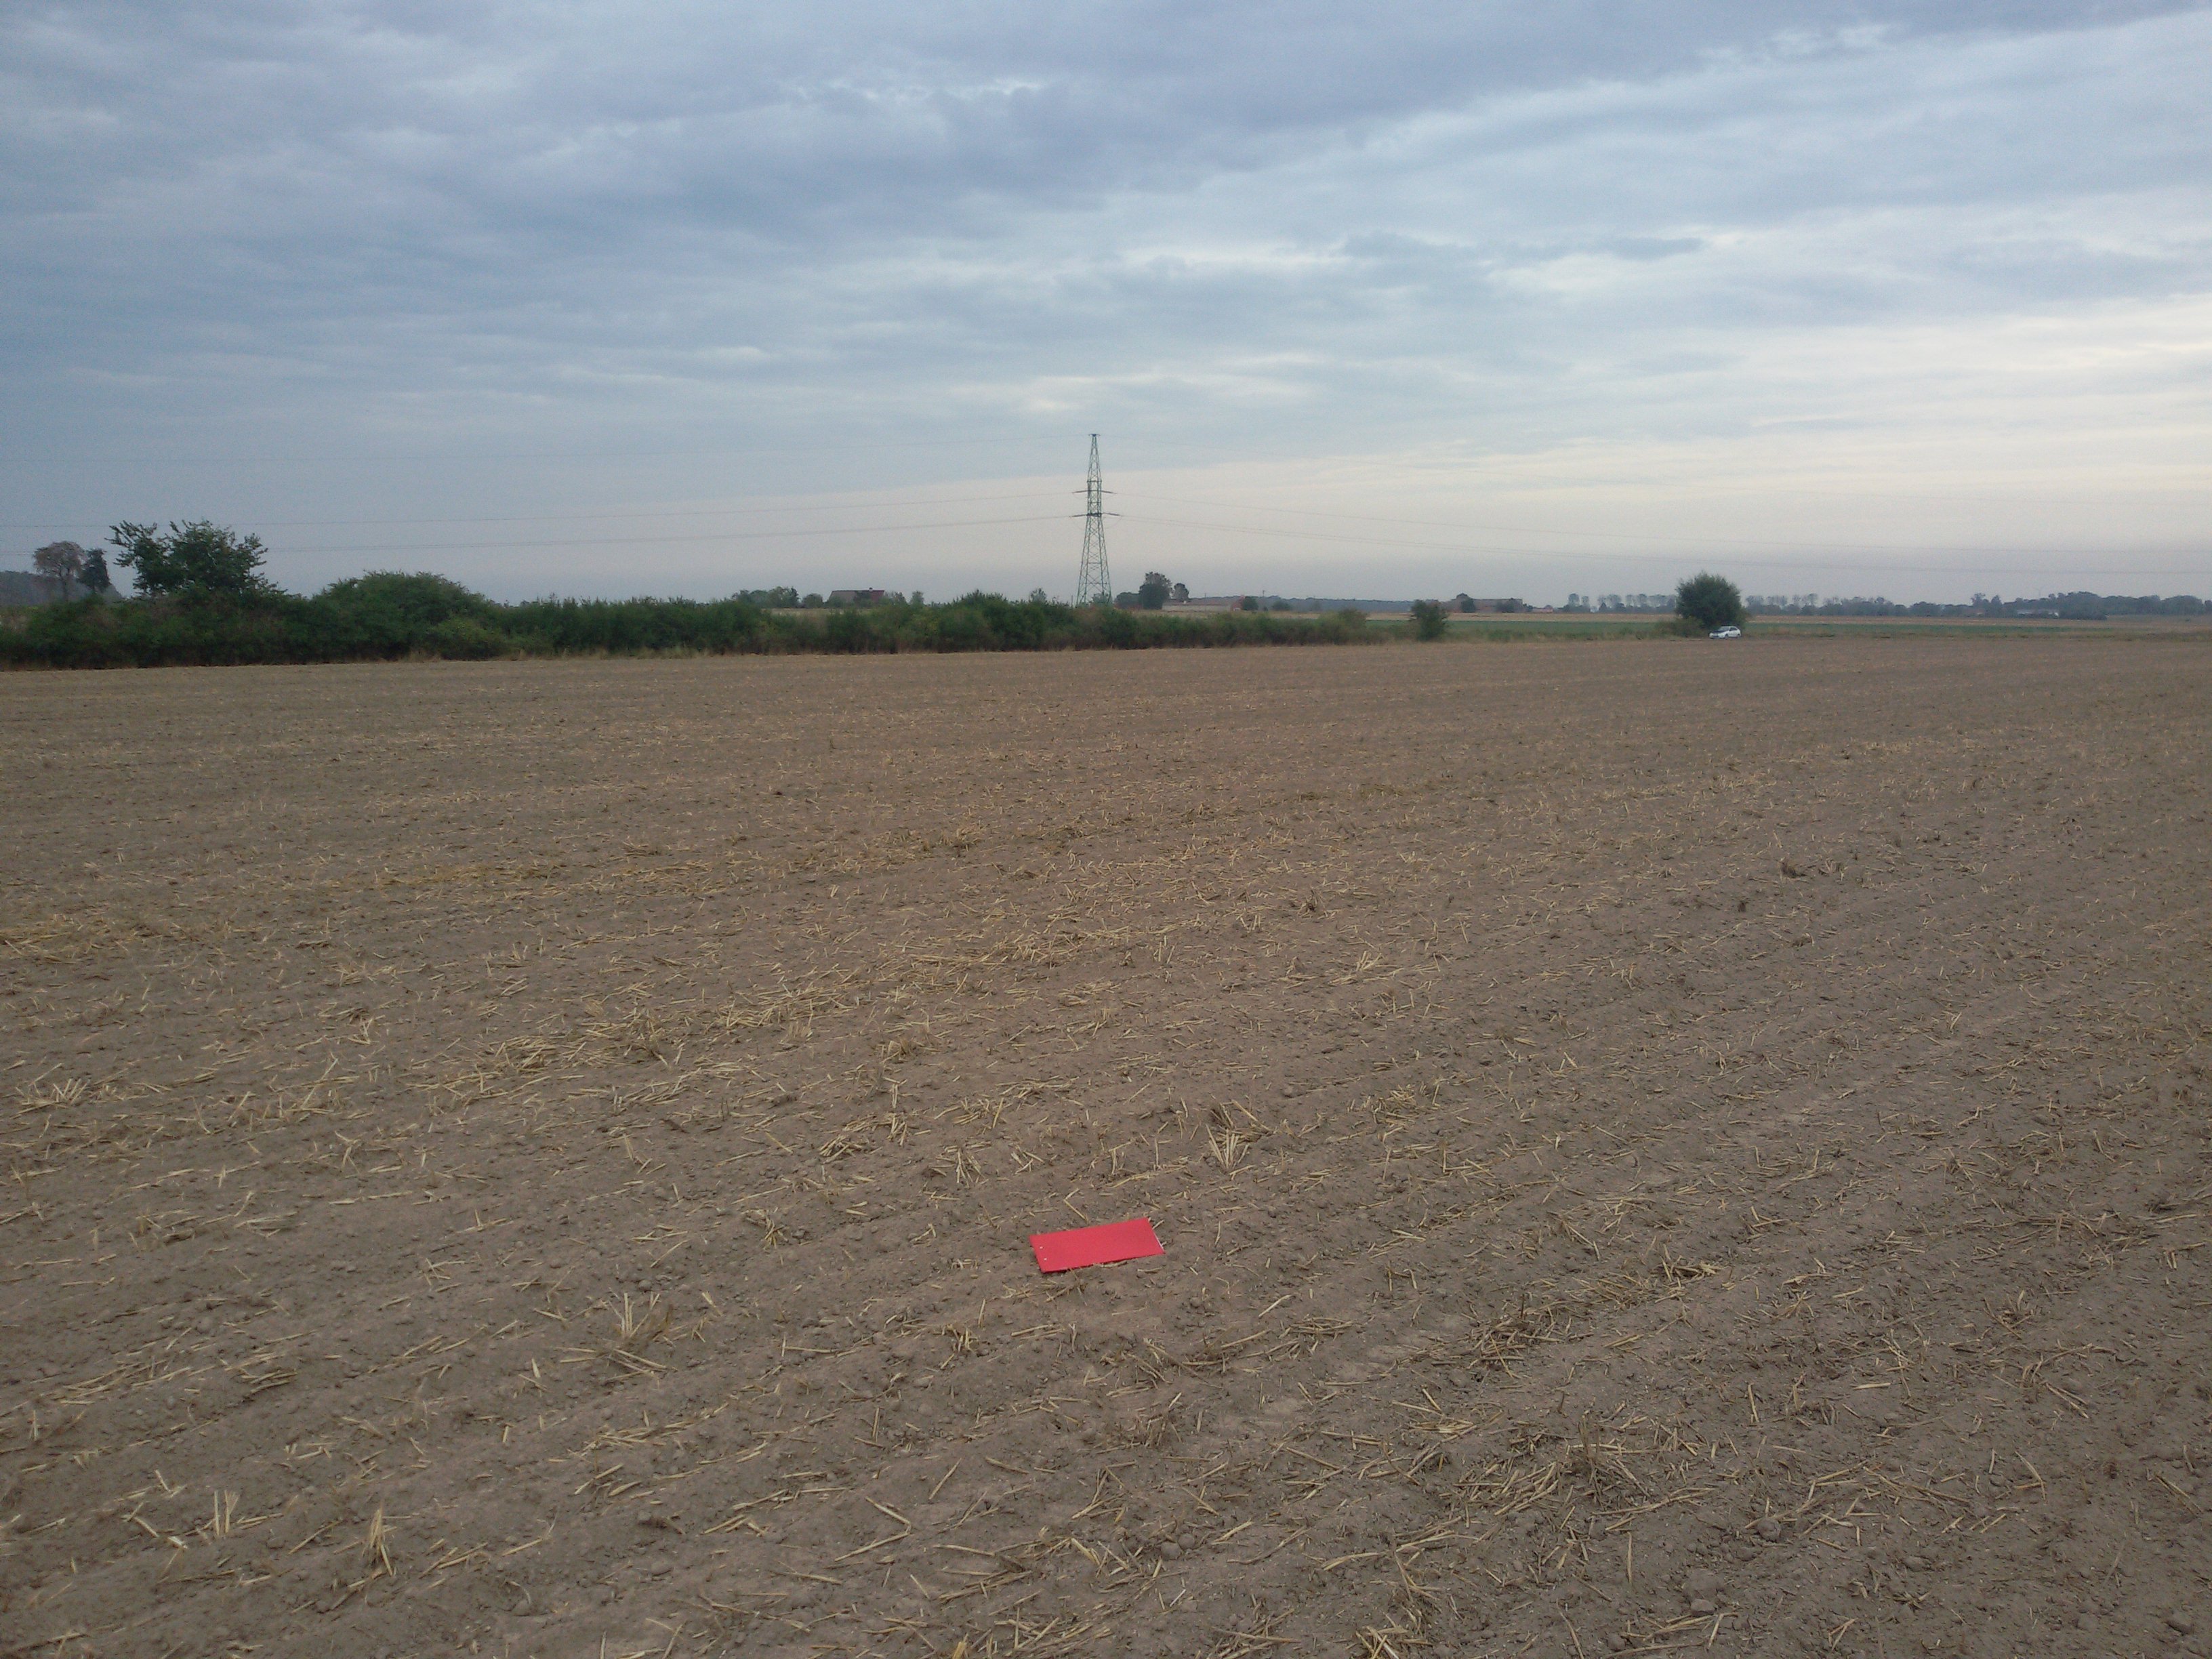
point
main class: Cropland
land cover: Common wheat
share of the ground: < 10 %
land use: Agriculture (excluding fallow land and kitchen gardens)
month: August
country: PL
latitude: 51.7718
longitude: 17.8843
